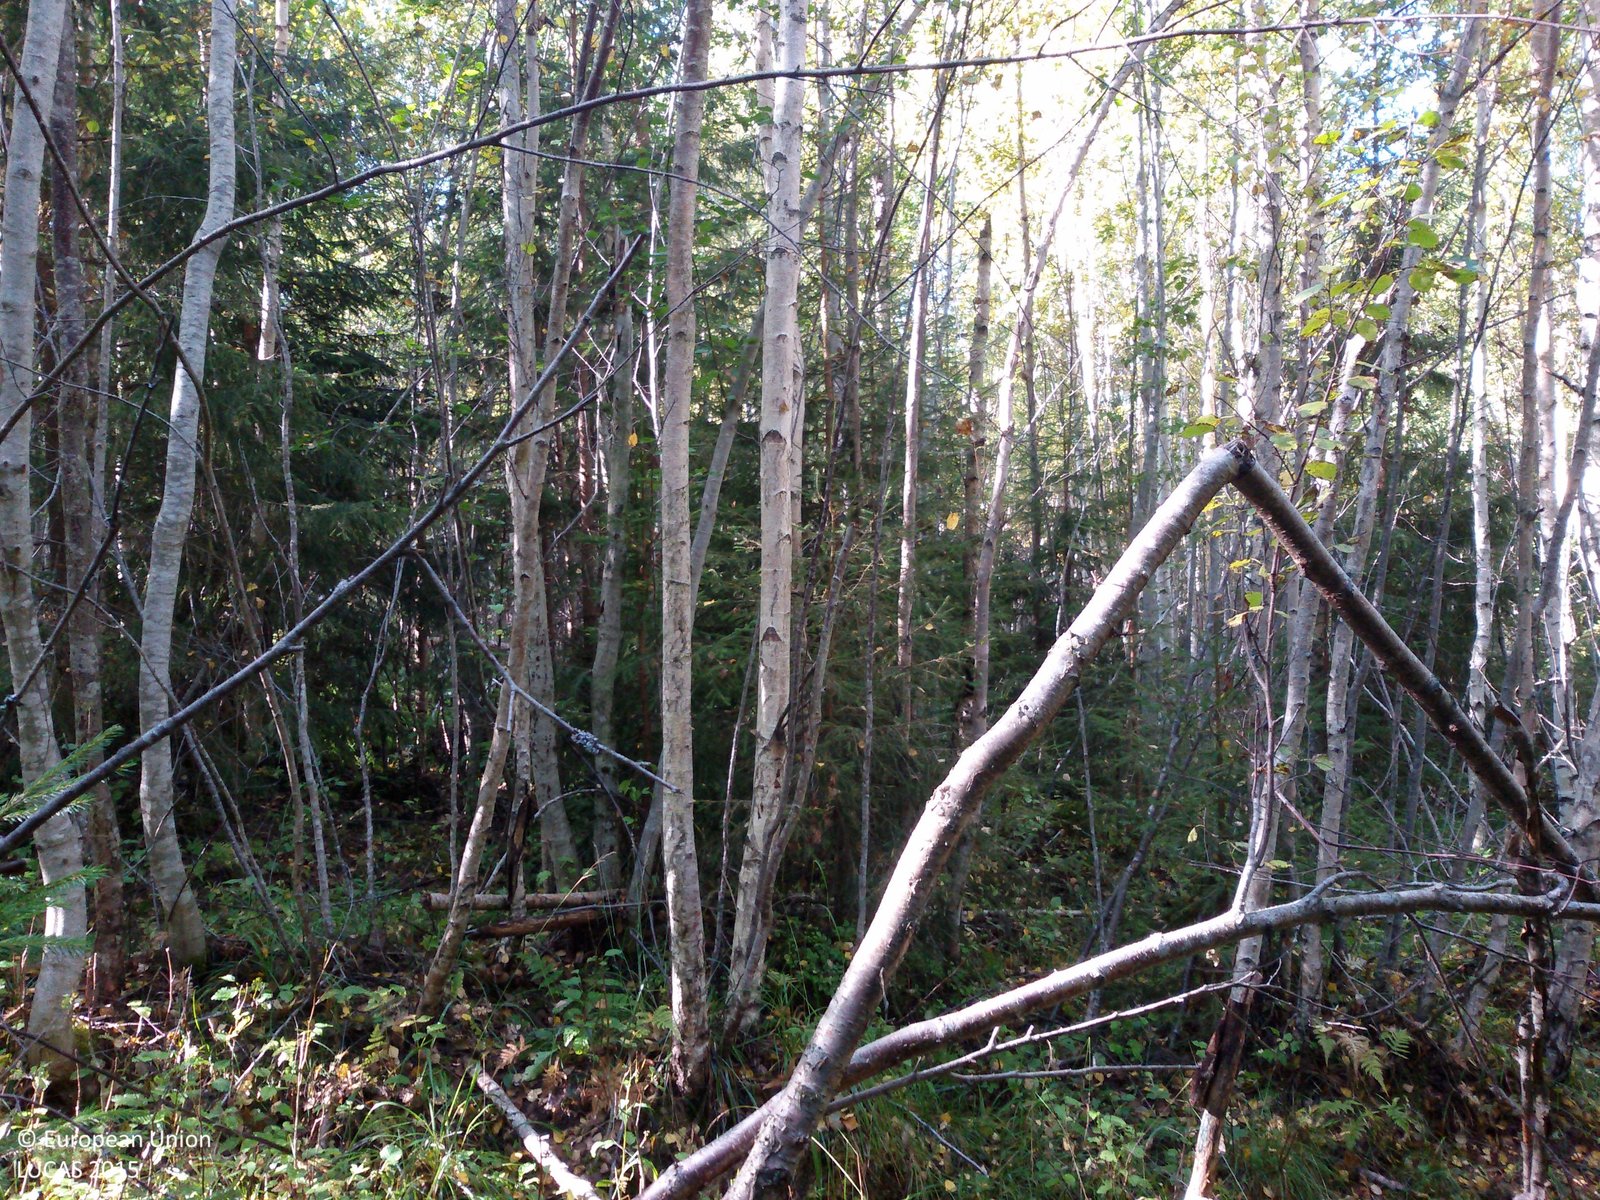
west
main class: Woodland
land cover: Spruce dominated mixed woodland
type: boreal forest
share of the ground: > 75 %
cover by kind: coniferous forest trees 45 %, broadleaved forest trees 45 %, herbaceous plants 5 %, lichens and mosses 5 %
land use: Forestry
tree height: > 5 m
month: September
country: SE
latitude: 60.7517
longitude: 14.7026
